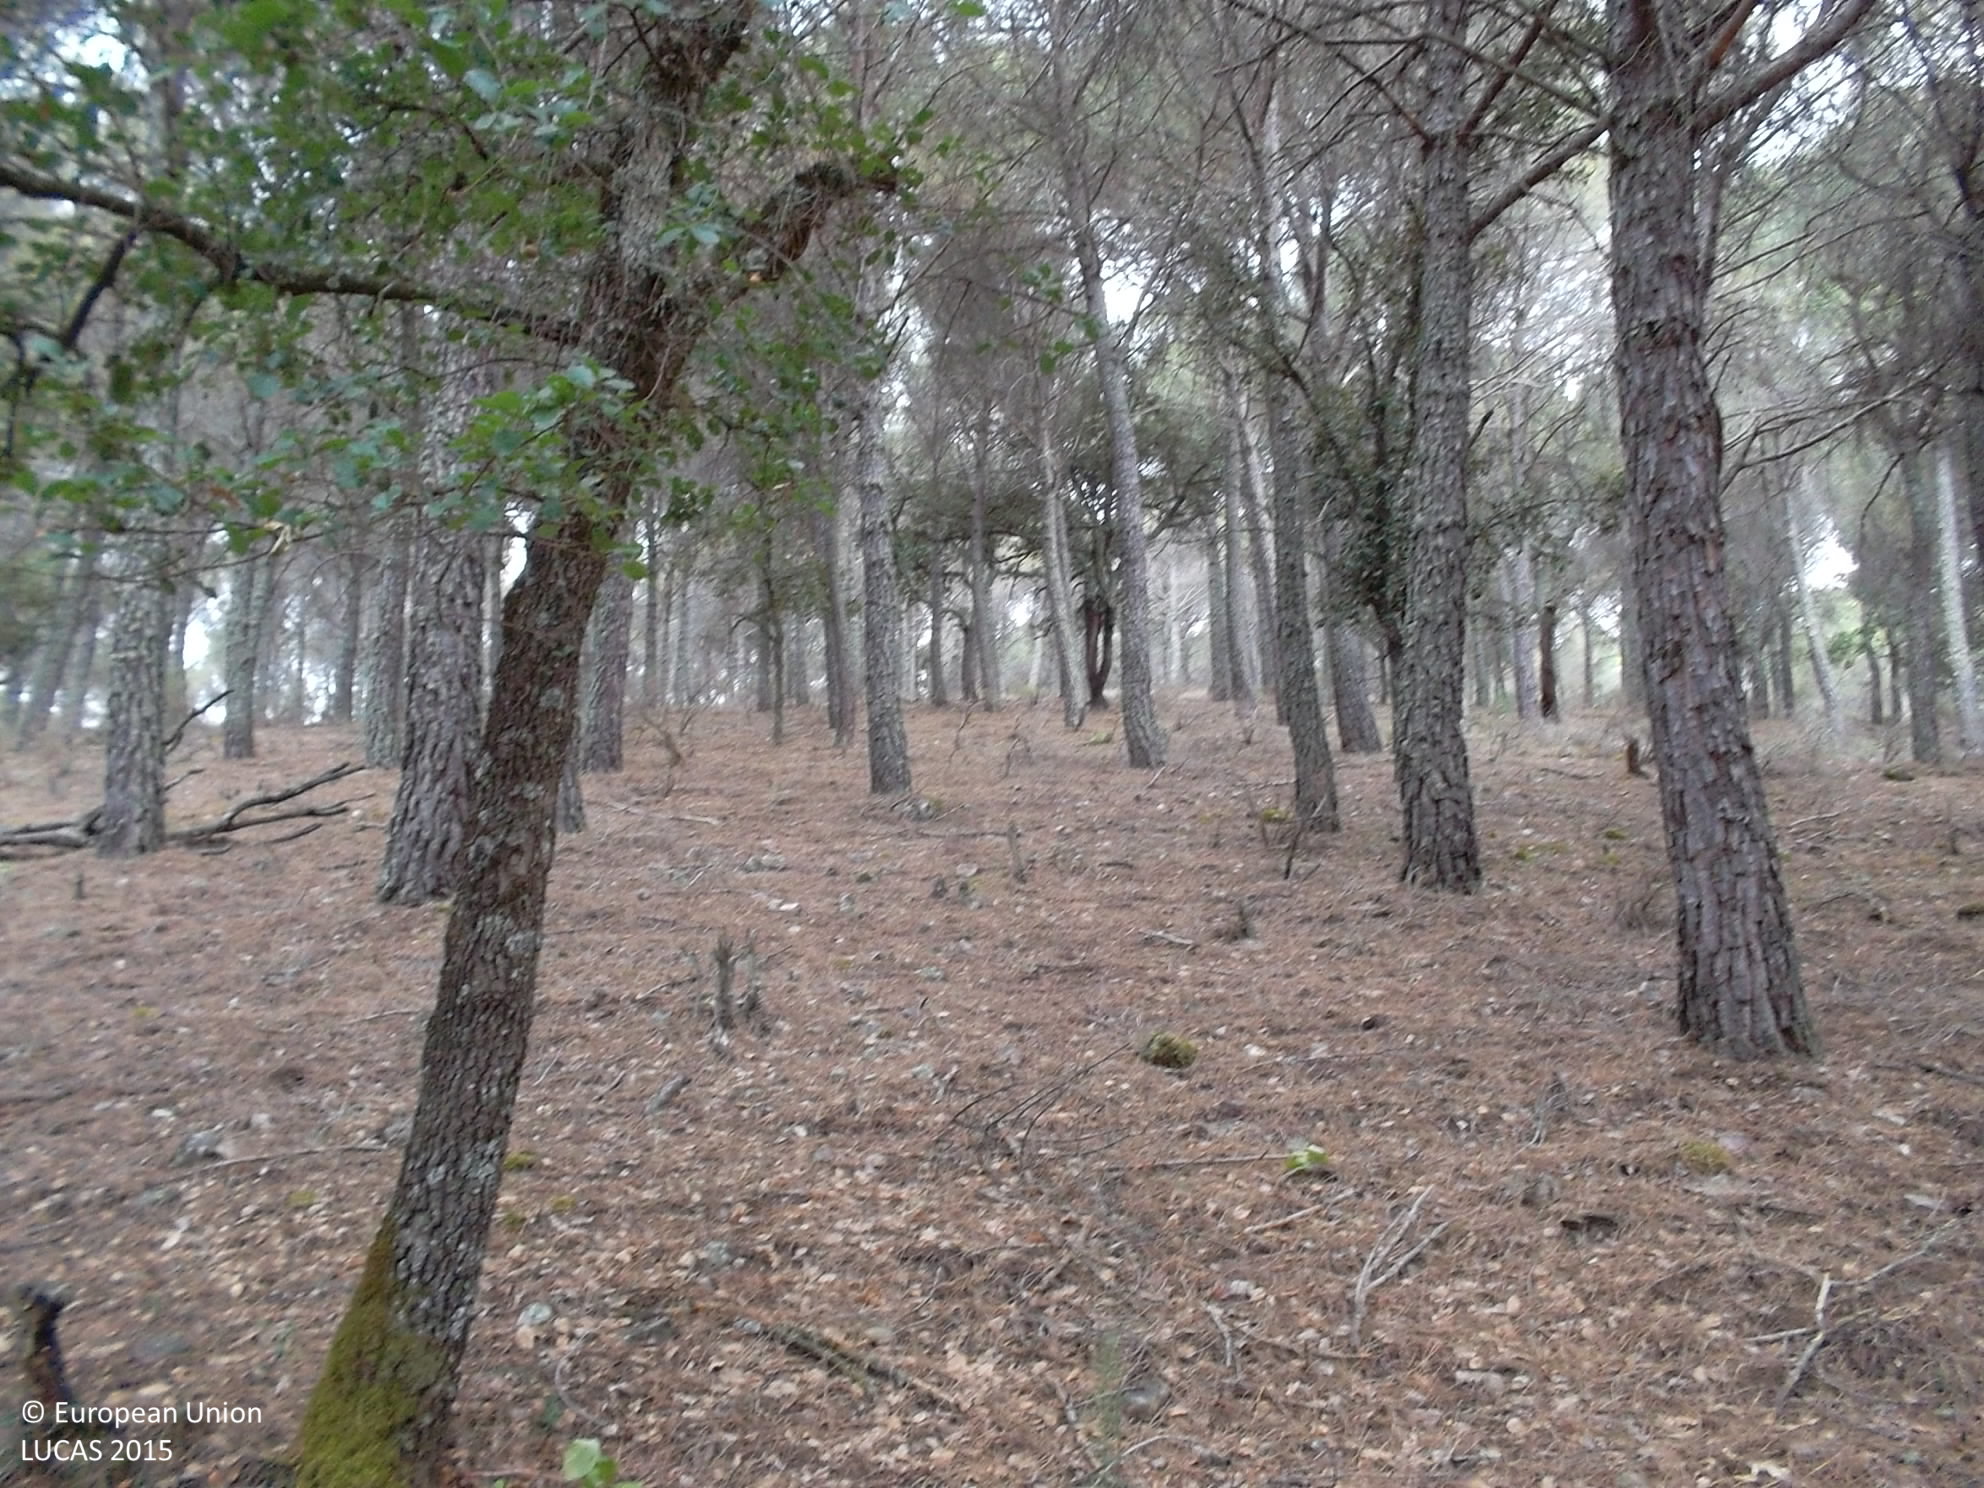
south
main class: Woodland
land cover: Pine dominated coniferous woodland
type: alpine coniferous forest
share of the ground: > 75 %
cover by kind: coniferous forest trees 100 %
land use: Forestry
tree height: > 5 m
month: June
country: ES
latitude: 39.0008
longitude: -4.4964
